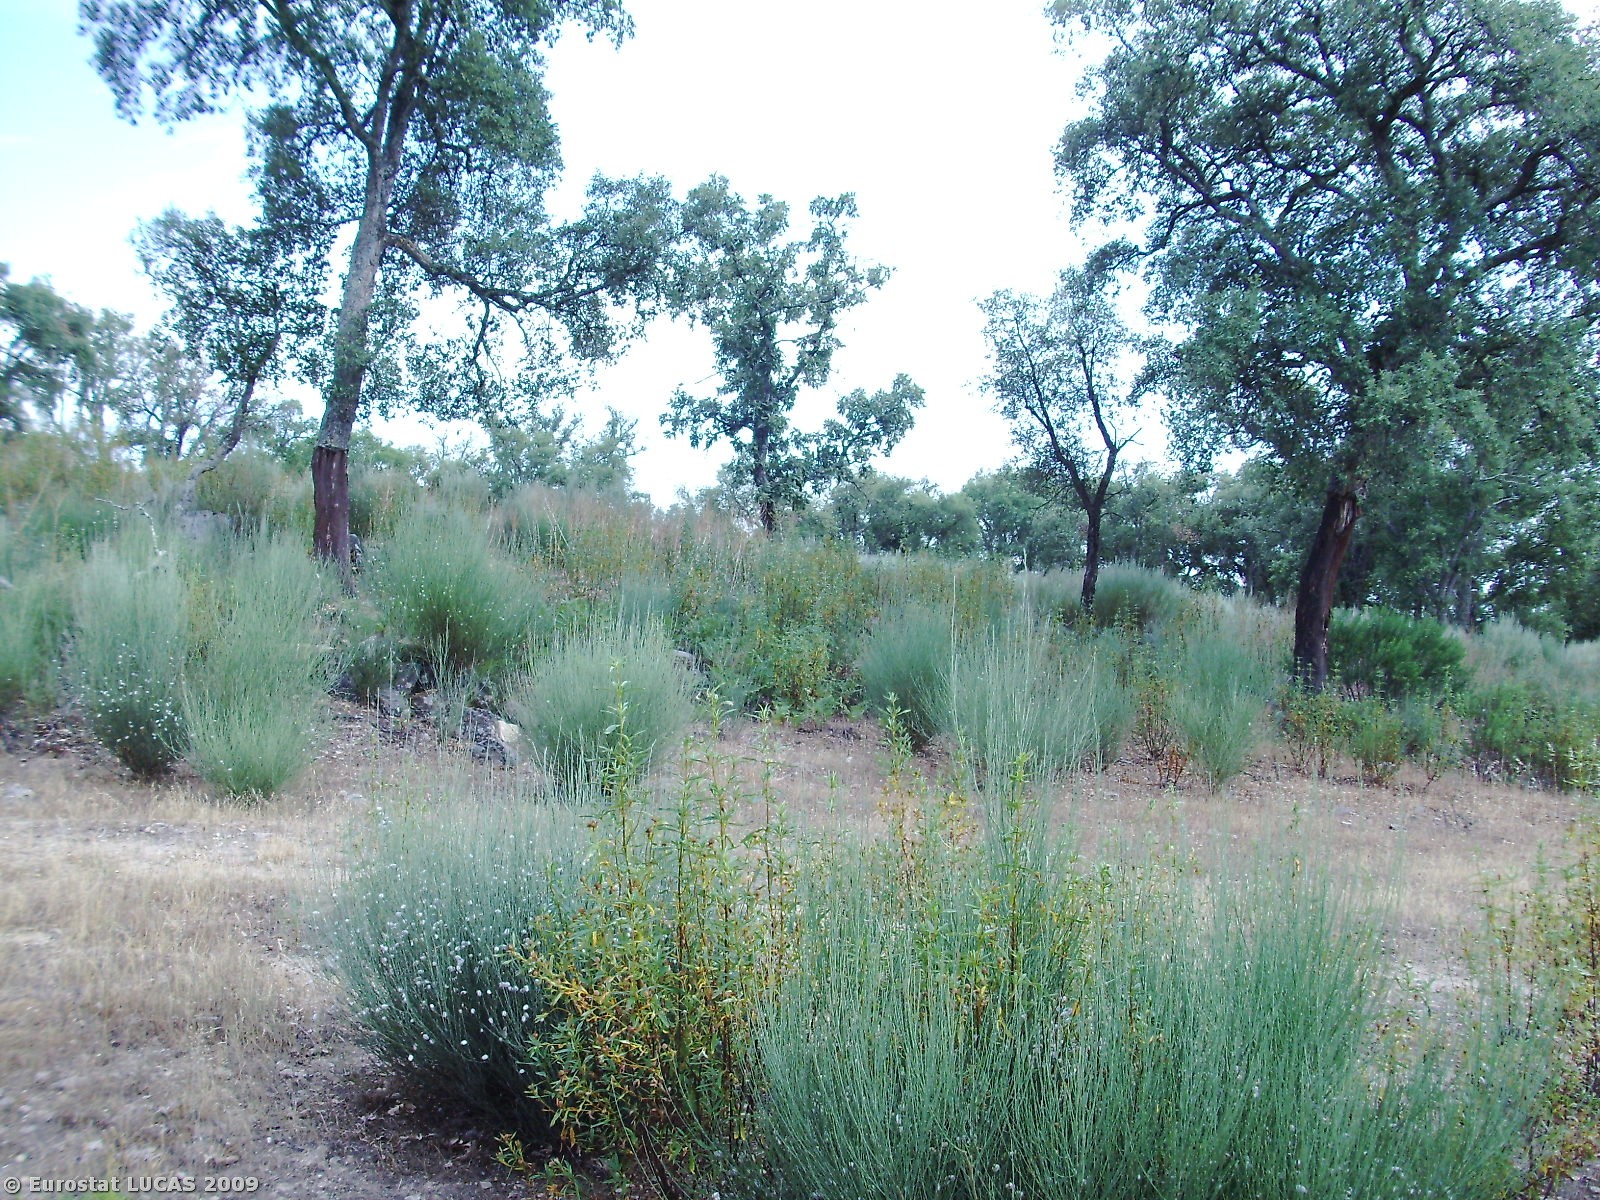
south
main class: Woodland
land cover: Broadleaved woodland
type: broadleaved evergreen forest
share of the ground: 25 - 50 %
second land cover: Spontaneously vegetated surfaces
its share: 50 - 75 %
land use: Forestry
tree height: > 5 m
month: June
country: PT
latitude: 39.3833
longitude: -7.4937
